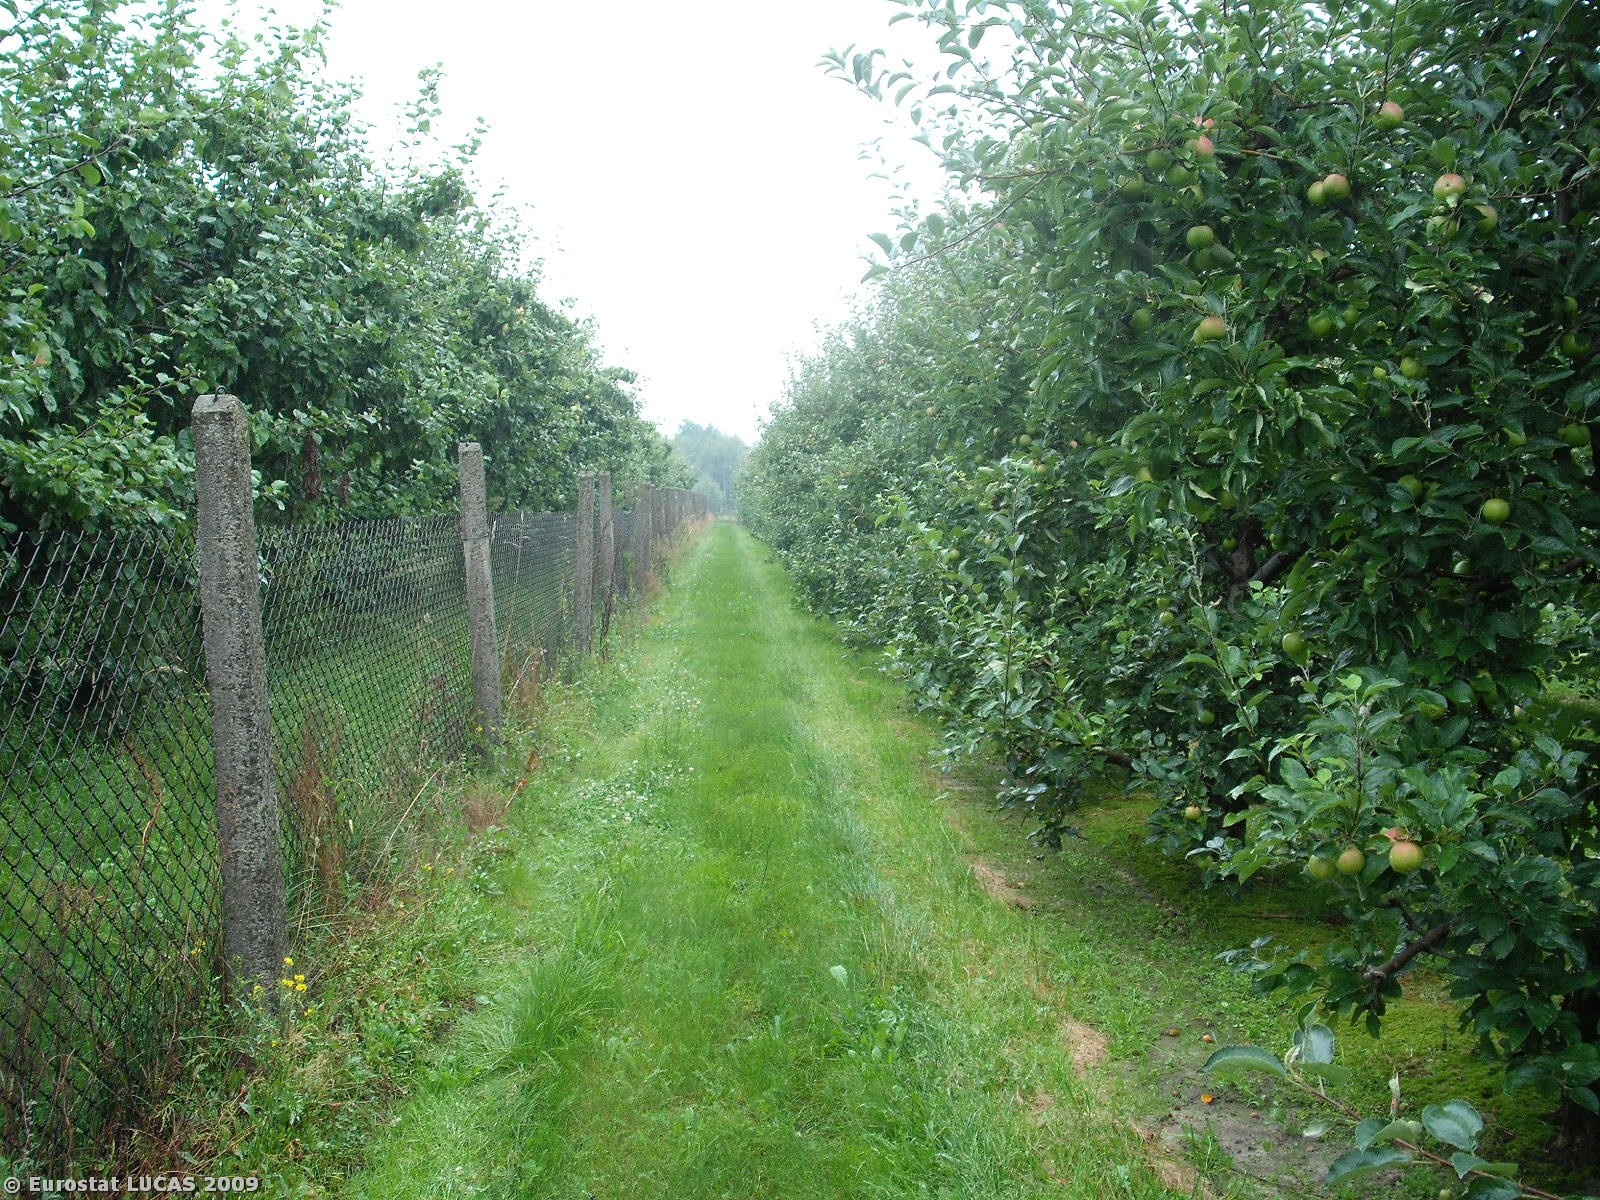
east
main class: Cropland
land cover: Apple fruit
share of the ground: > 75 %
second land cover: Grassland with sparse tree/shrub cover
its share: > 75 %
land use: Agriculture (excluding fallow land and kitchen gardens)
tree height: < 5 m
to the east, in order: Apple fruit; Grassland with sparse tree/shrub cover; Fences; Apple fruit; Fences; Tracks; Rye; Grassland without tree/shrub cover; Grassland with sparse tree/shrub cover
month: August
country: PL
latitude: 51.9211
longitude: 21.1699
